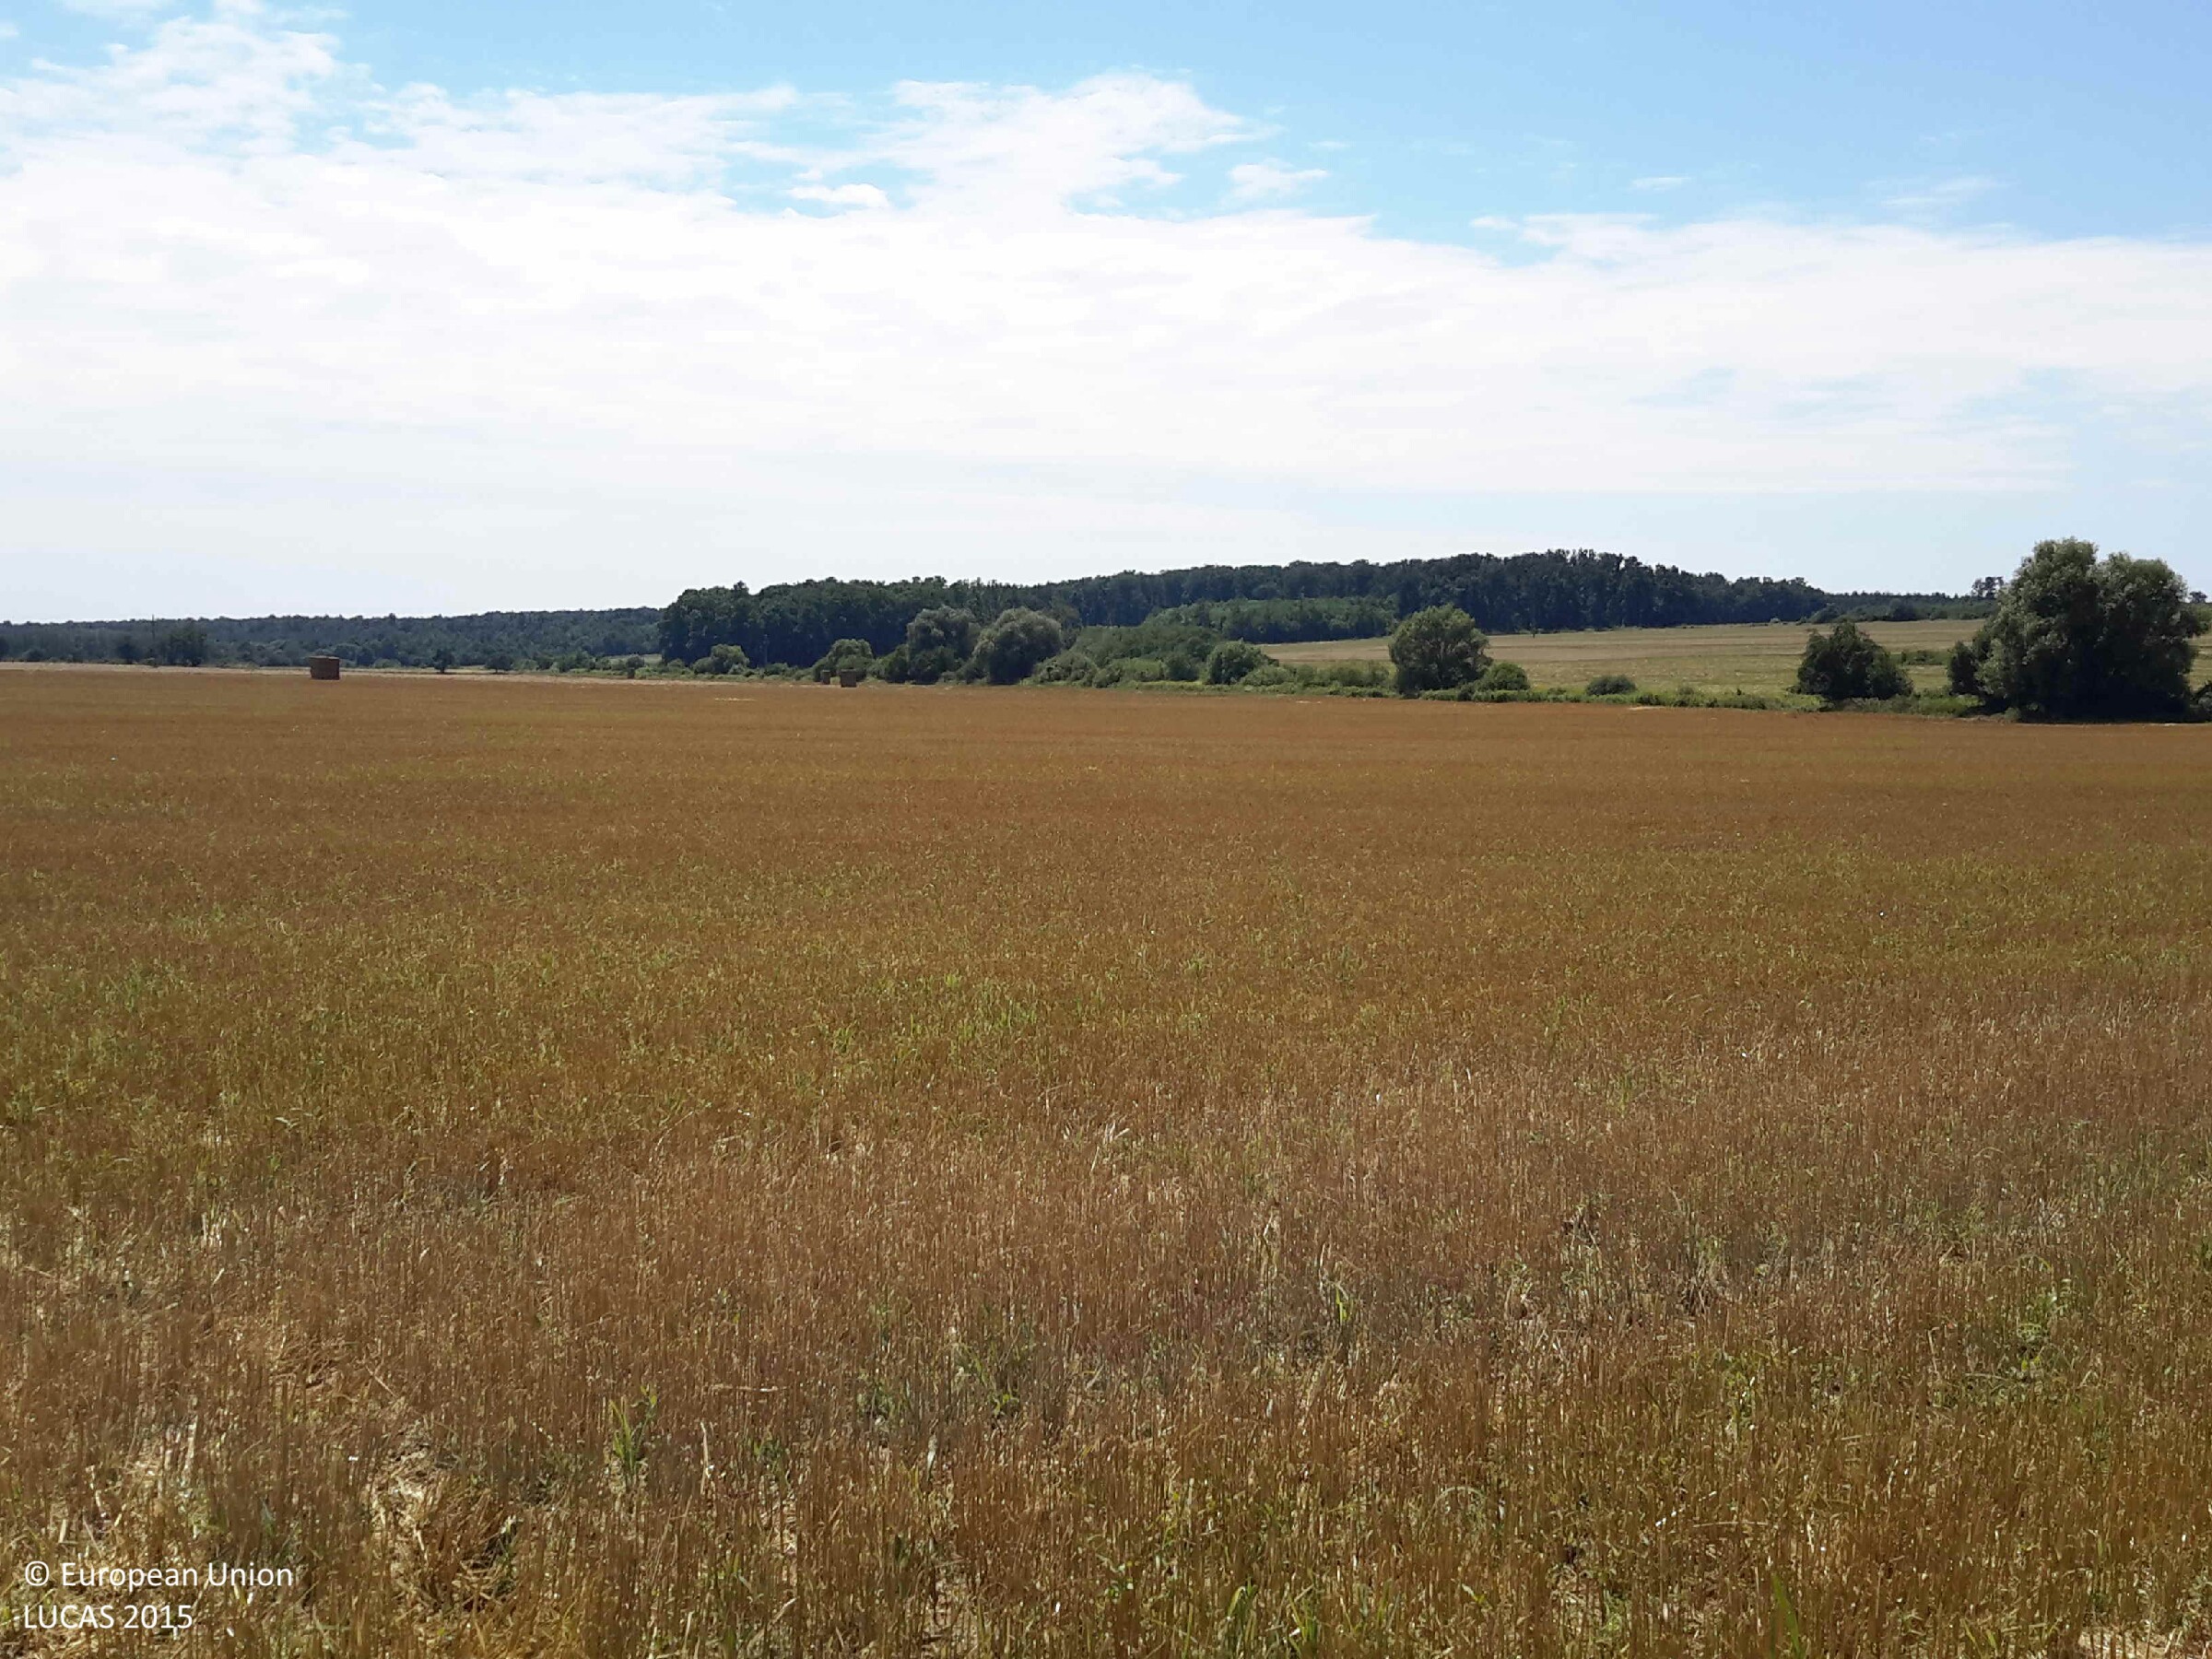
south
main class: Cropland
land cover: Common wheat
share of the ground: > 75 %
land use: Agriculture (excluding fallow land and kitchen gardens)
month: July
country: HU
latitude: 47.1957
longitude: 16.5898
